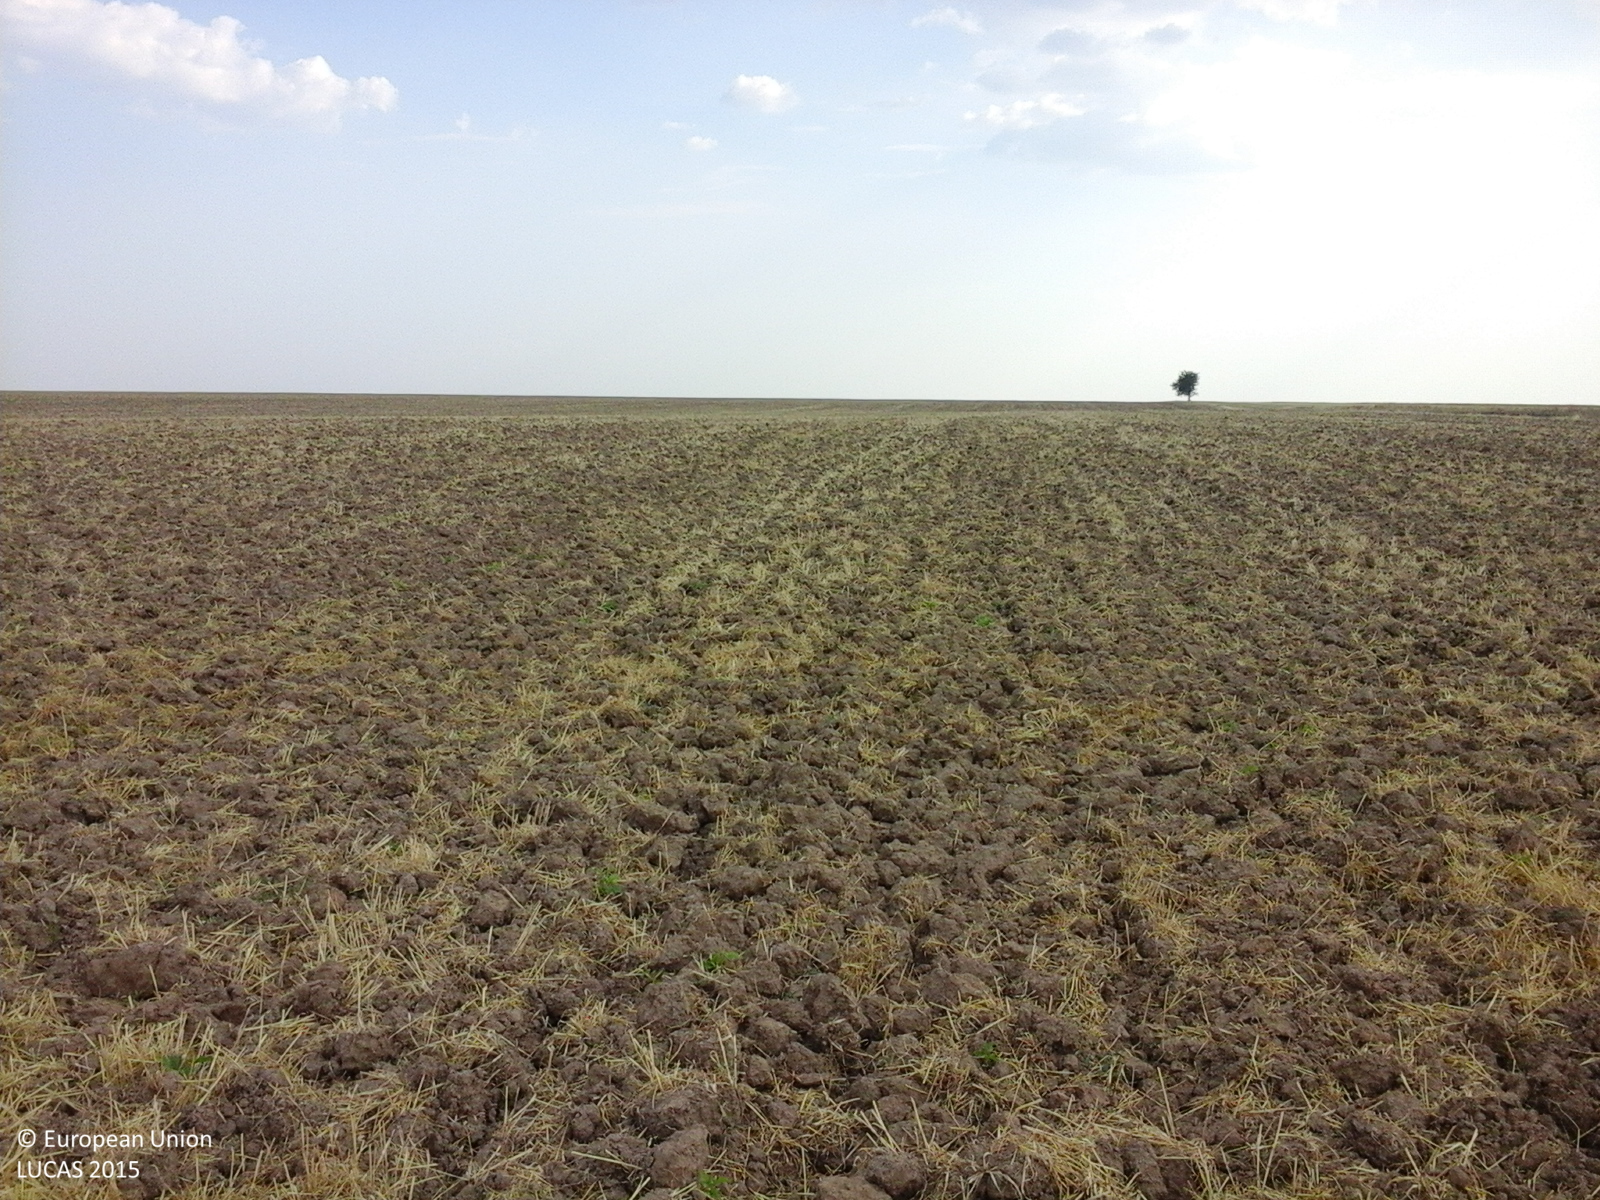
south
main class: Cropland
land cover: Durum wheat
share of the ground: 10 - 25 %
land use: Agriculture (excluding fallow land and kitchen gardens)
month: August
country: RO
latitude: 44.2808
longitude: 23.1144
